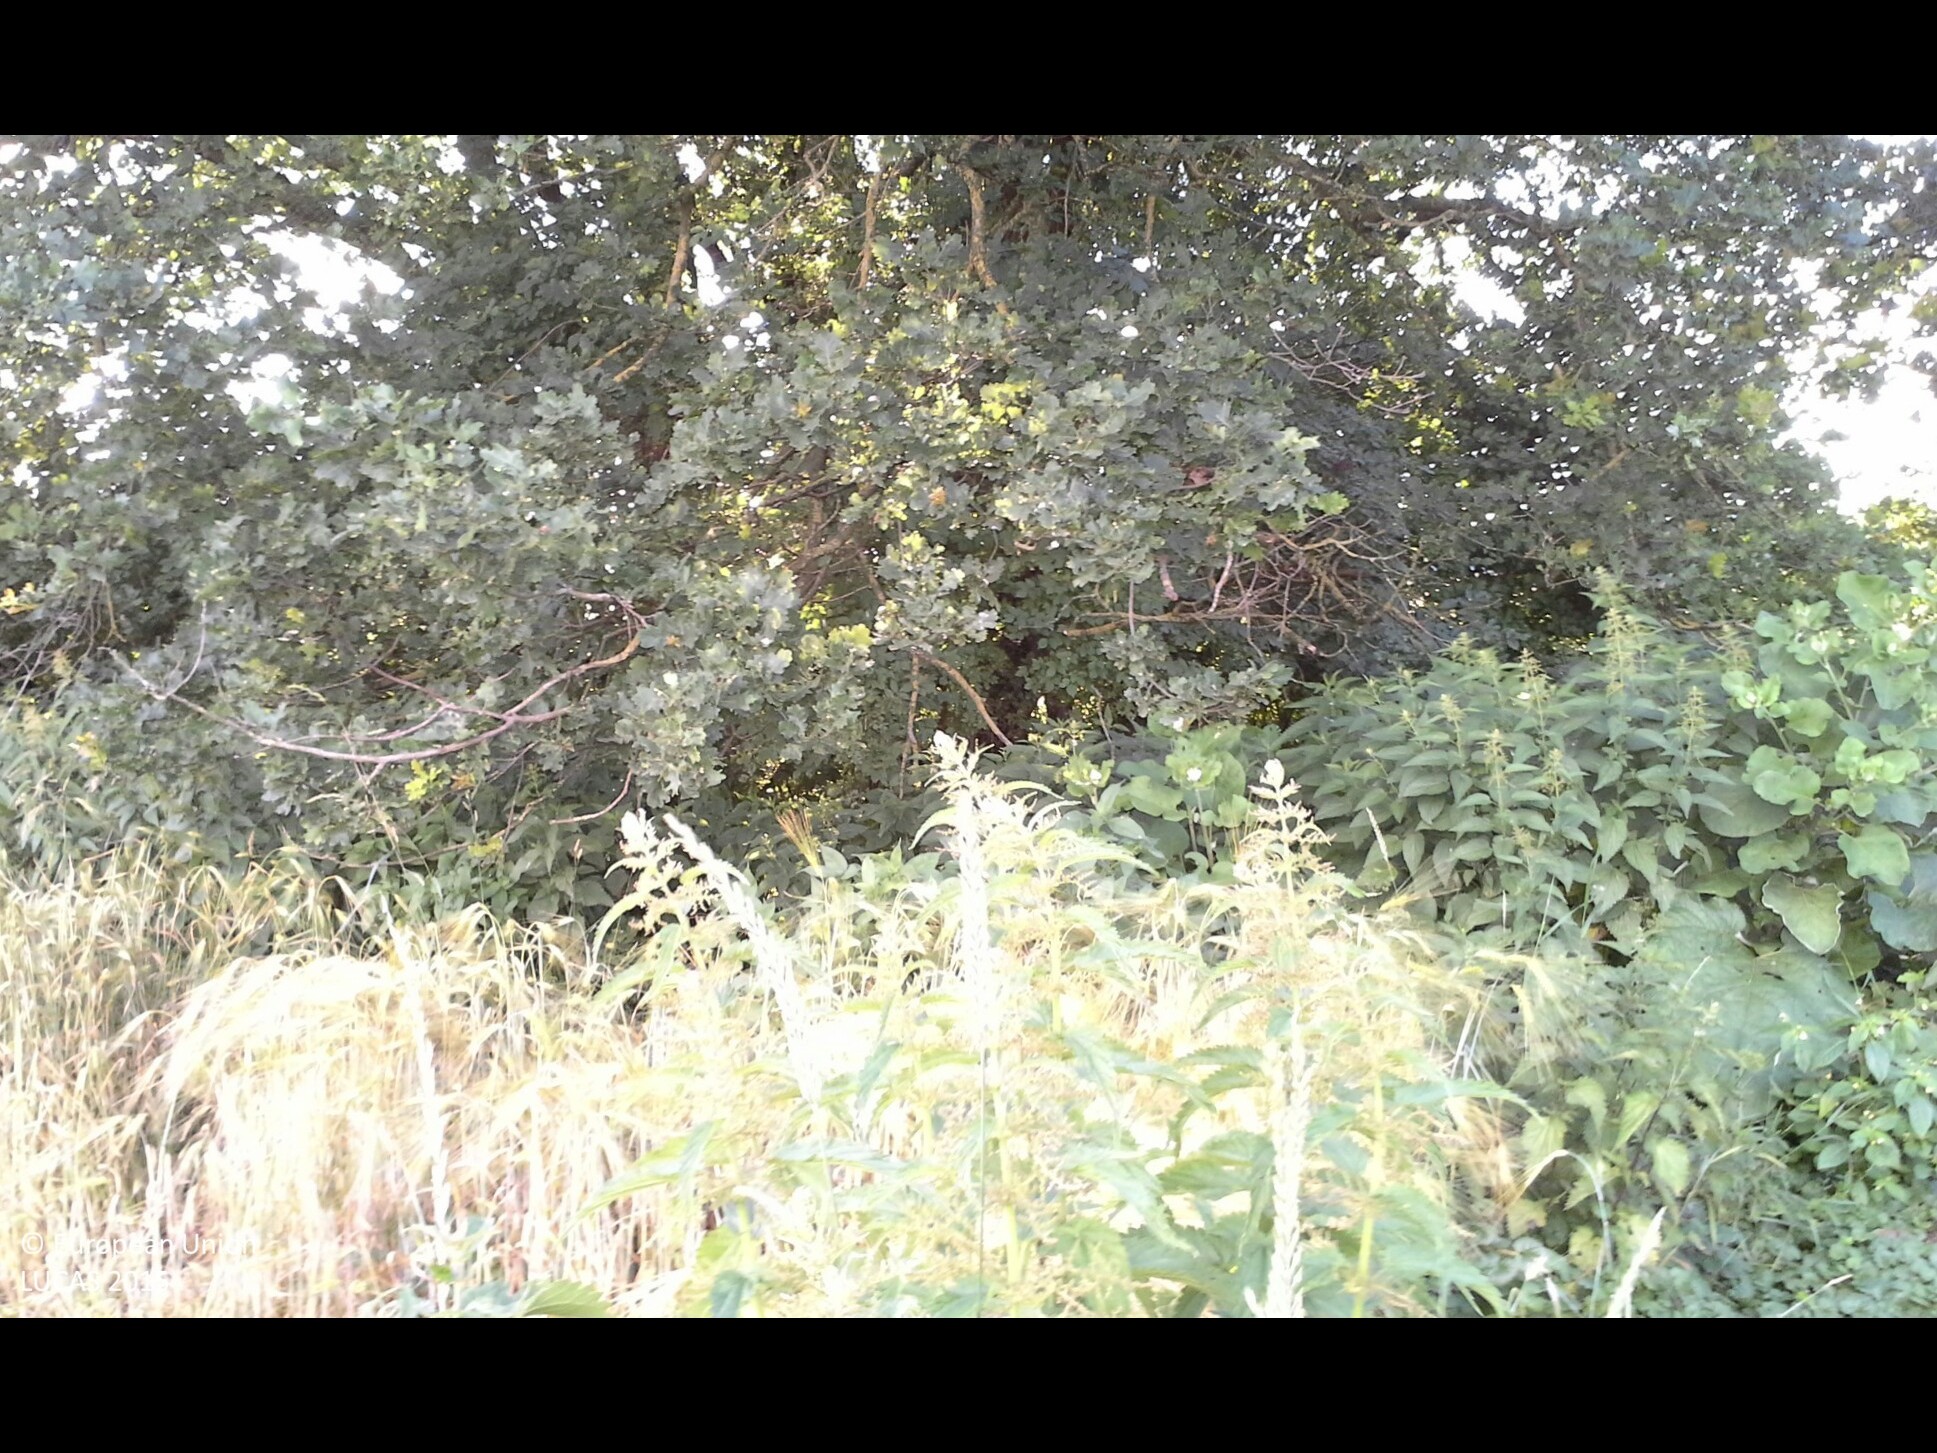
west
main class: Cropland
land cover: Sugar beet
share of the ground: > 75 %
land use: Agriculture (excluding fallow land and kitchen gardens)
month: June
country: AT
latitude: 48.0520
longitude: 14.6826
